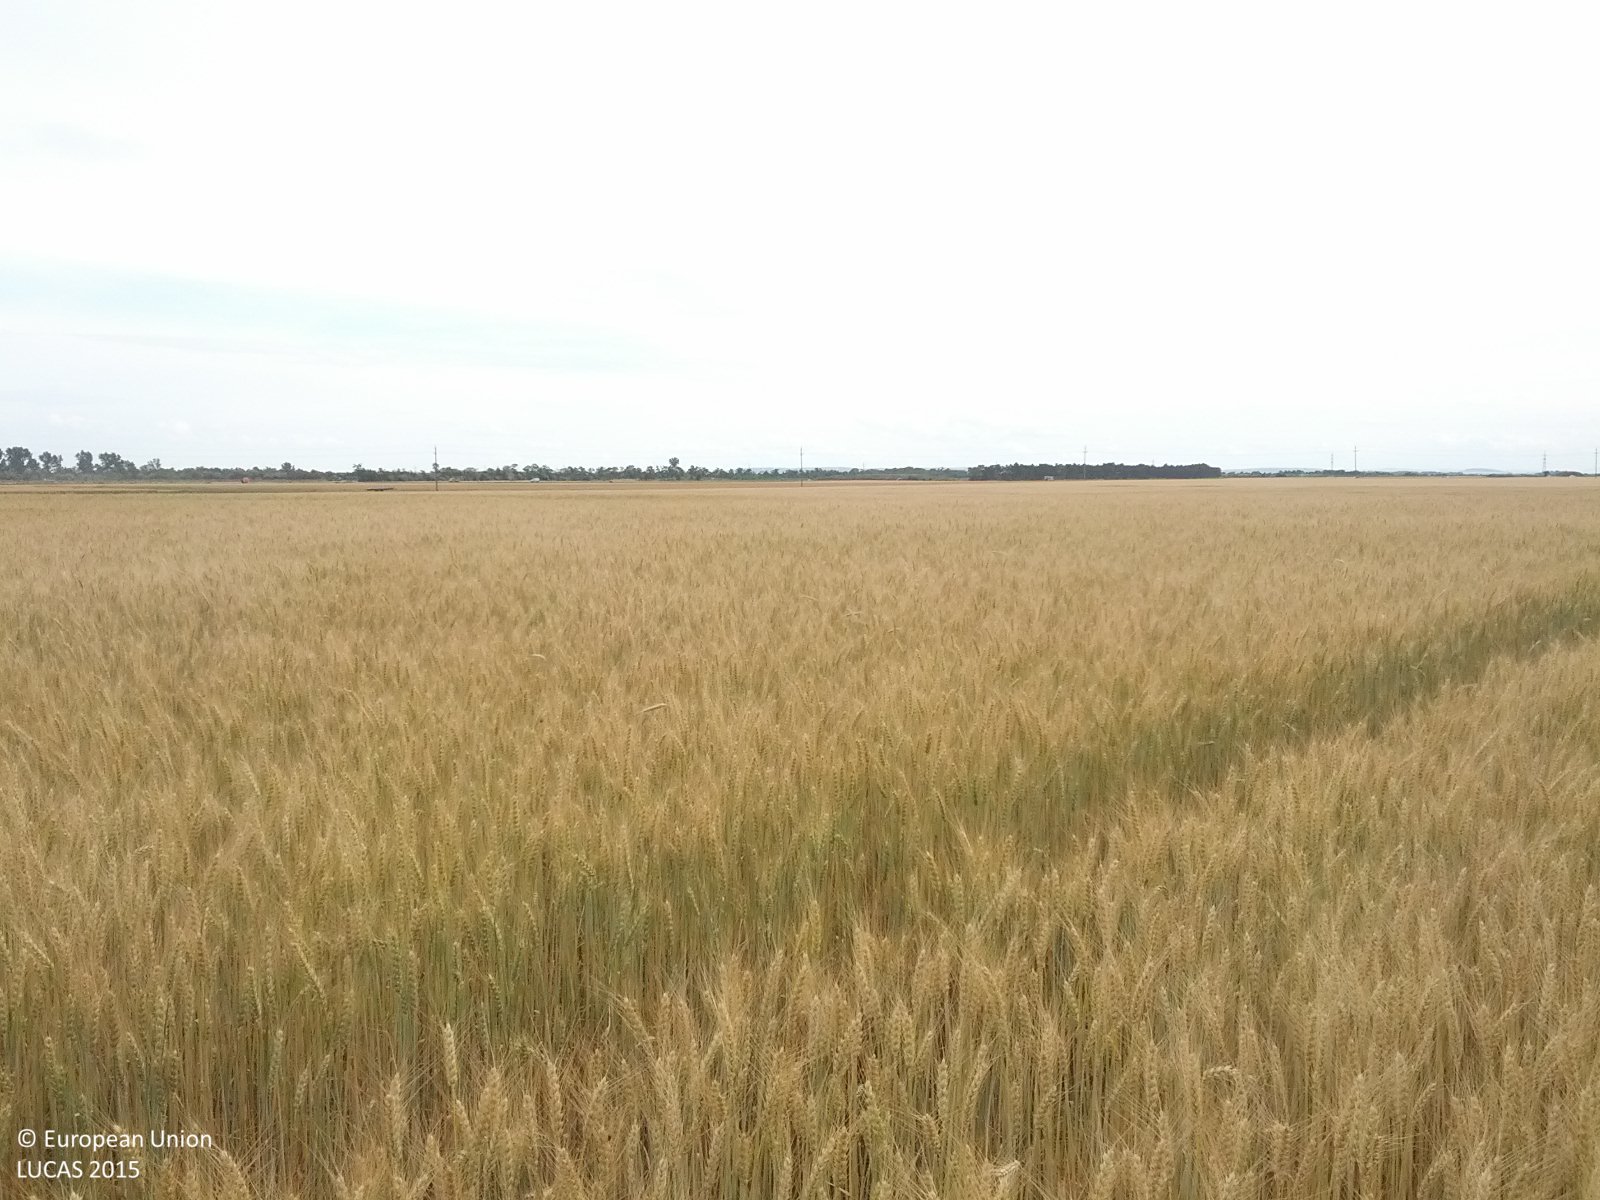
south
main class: Cropland
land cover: Common wheat
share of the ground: > 75 %
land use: Agriculture (excluding fallow land and kitchen gardens)
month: June
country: AT
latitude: 48.2673
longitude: 16.7832
